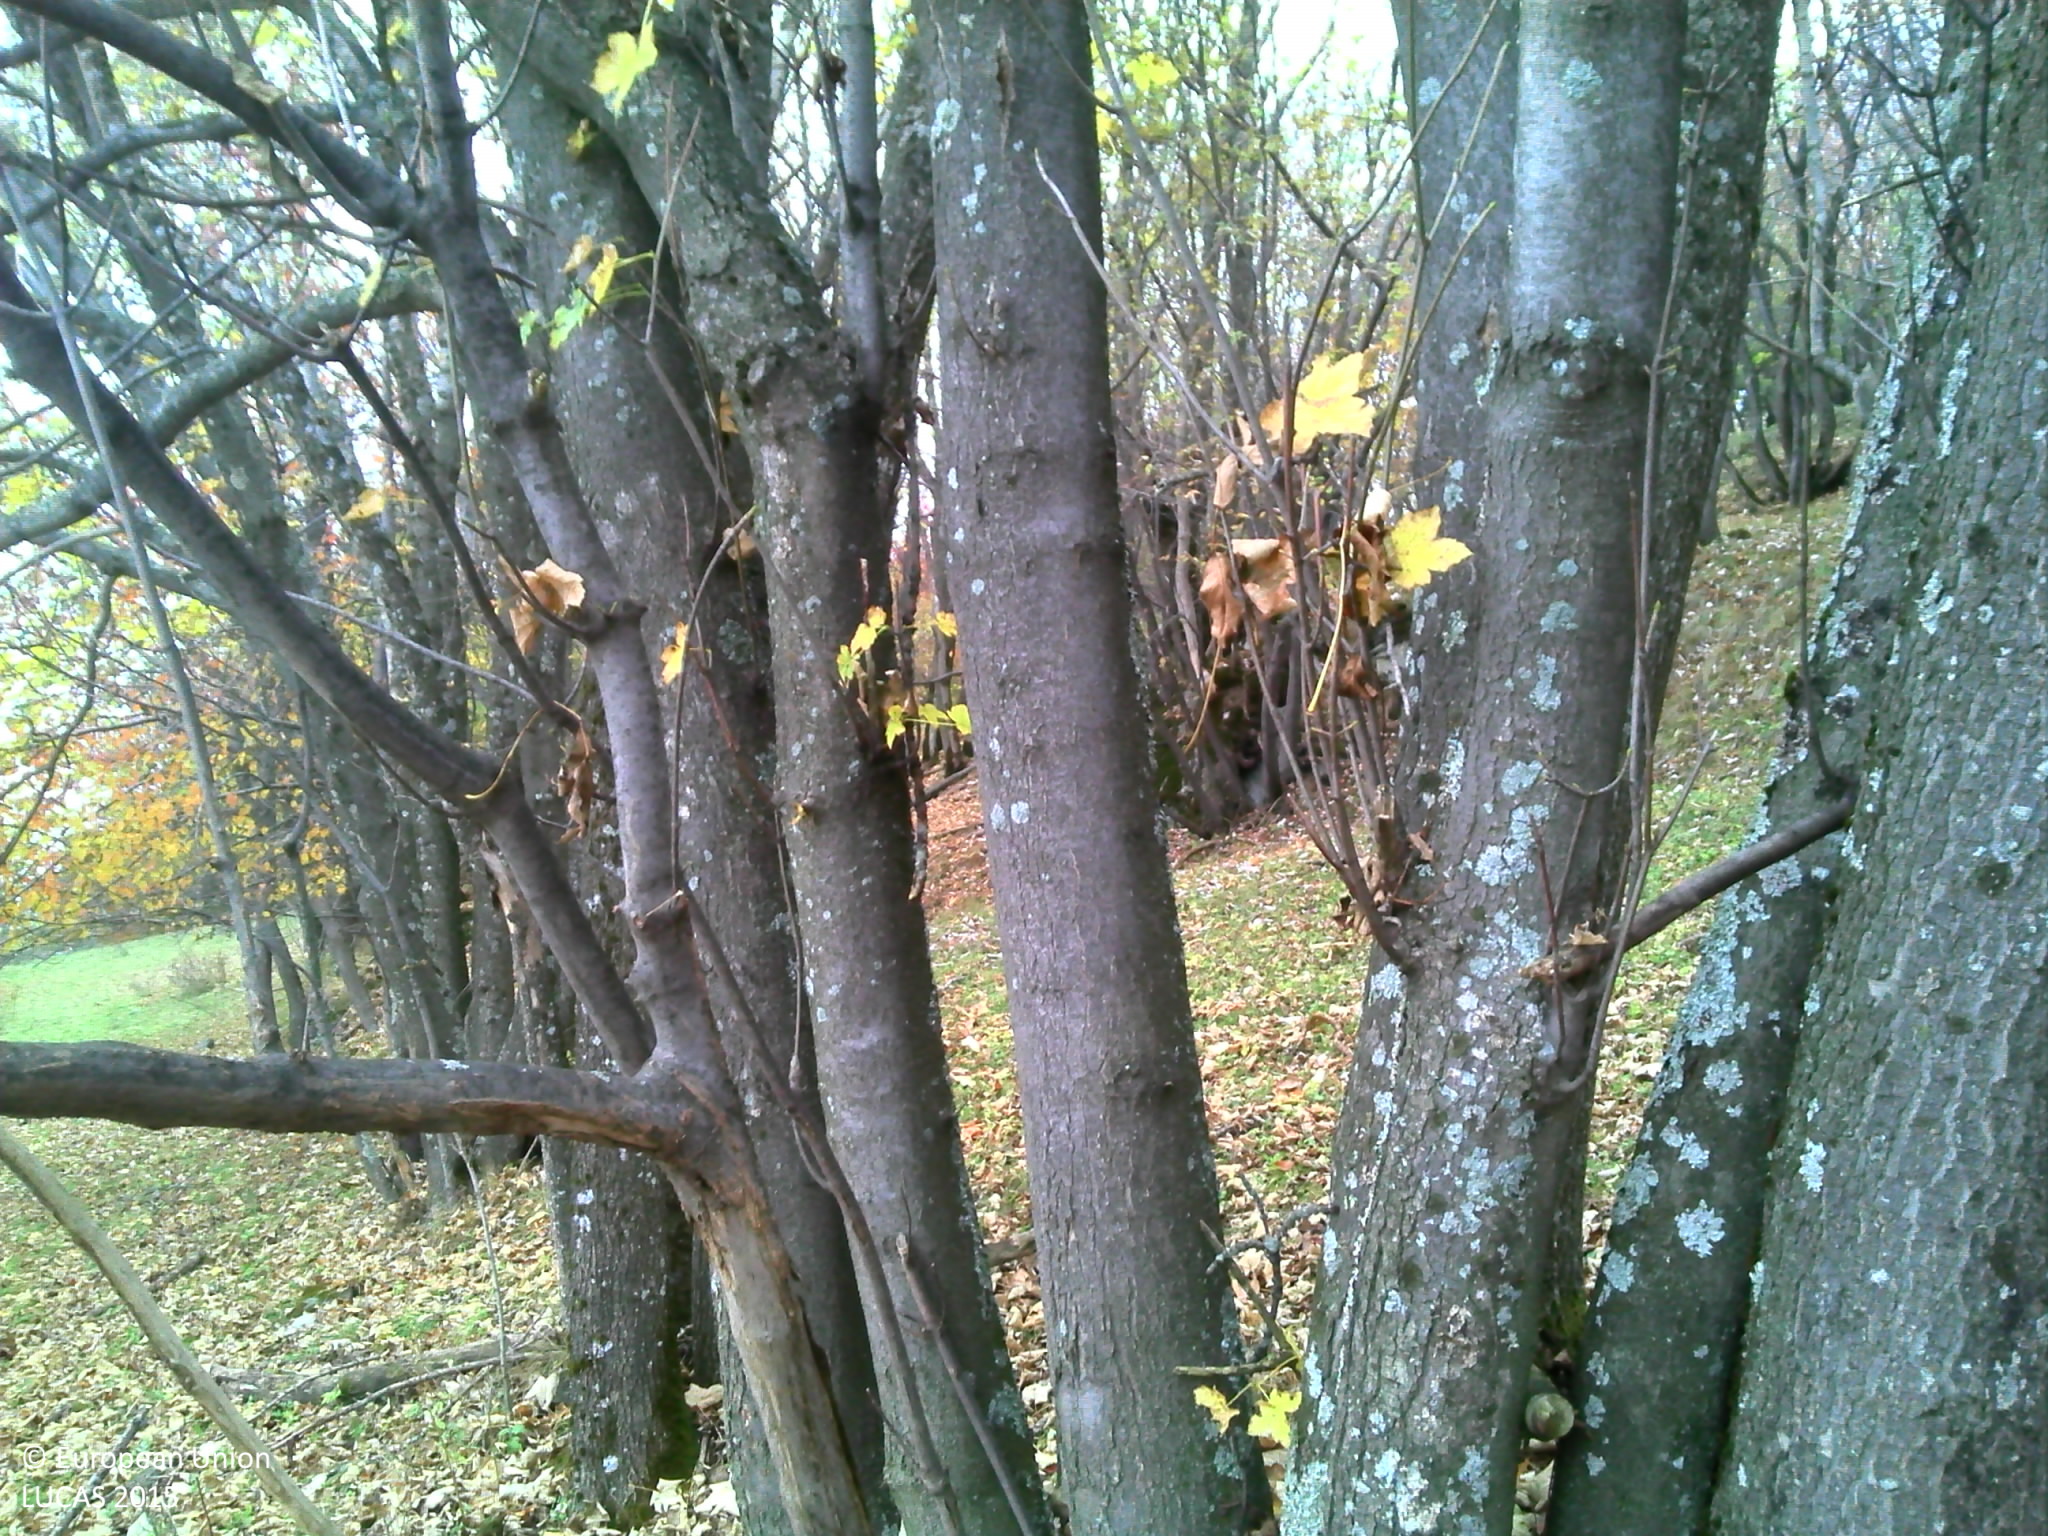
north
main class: Woodland
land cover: Broadleaved woodland
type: mesophytic deciduous forest
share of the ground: > 75 %
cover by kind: broadleaved forest trees 80 %, herbaceous plants 20 %
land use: Forestry
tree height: > 5 m
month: October
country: FR
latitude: 45.2472
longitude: 6.4758
